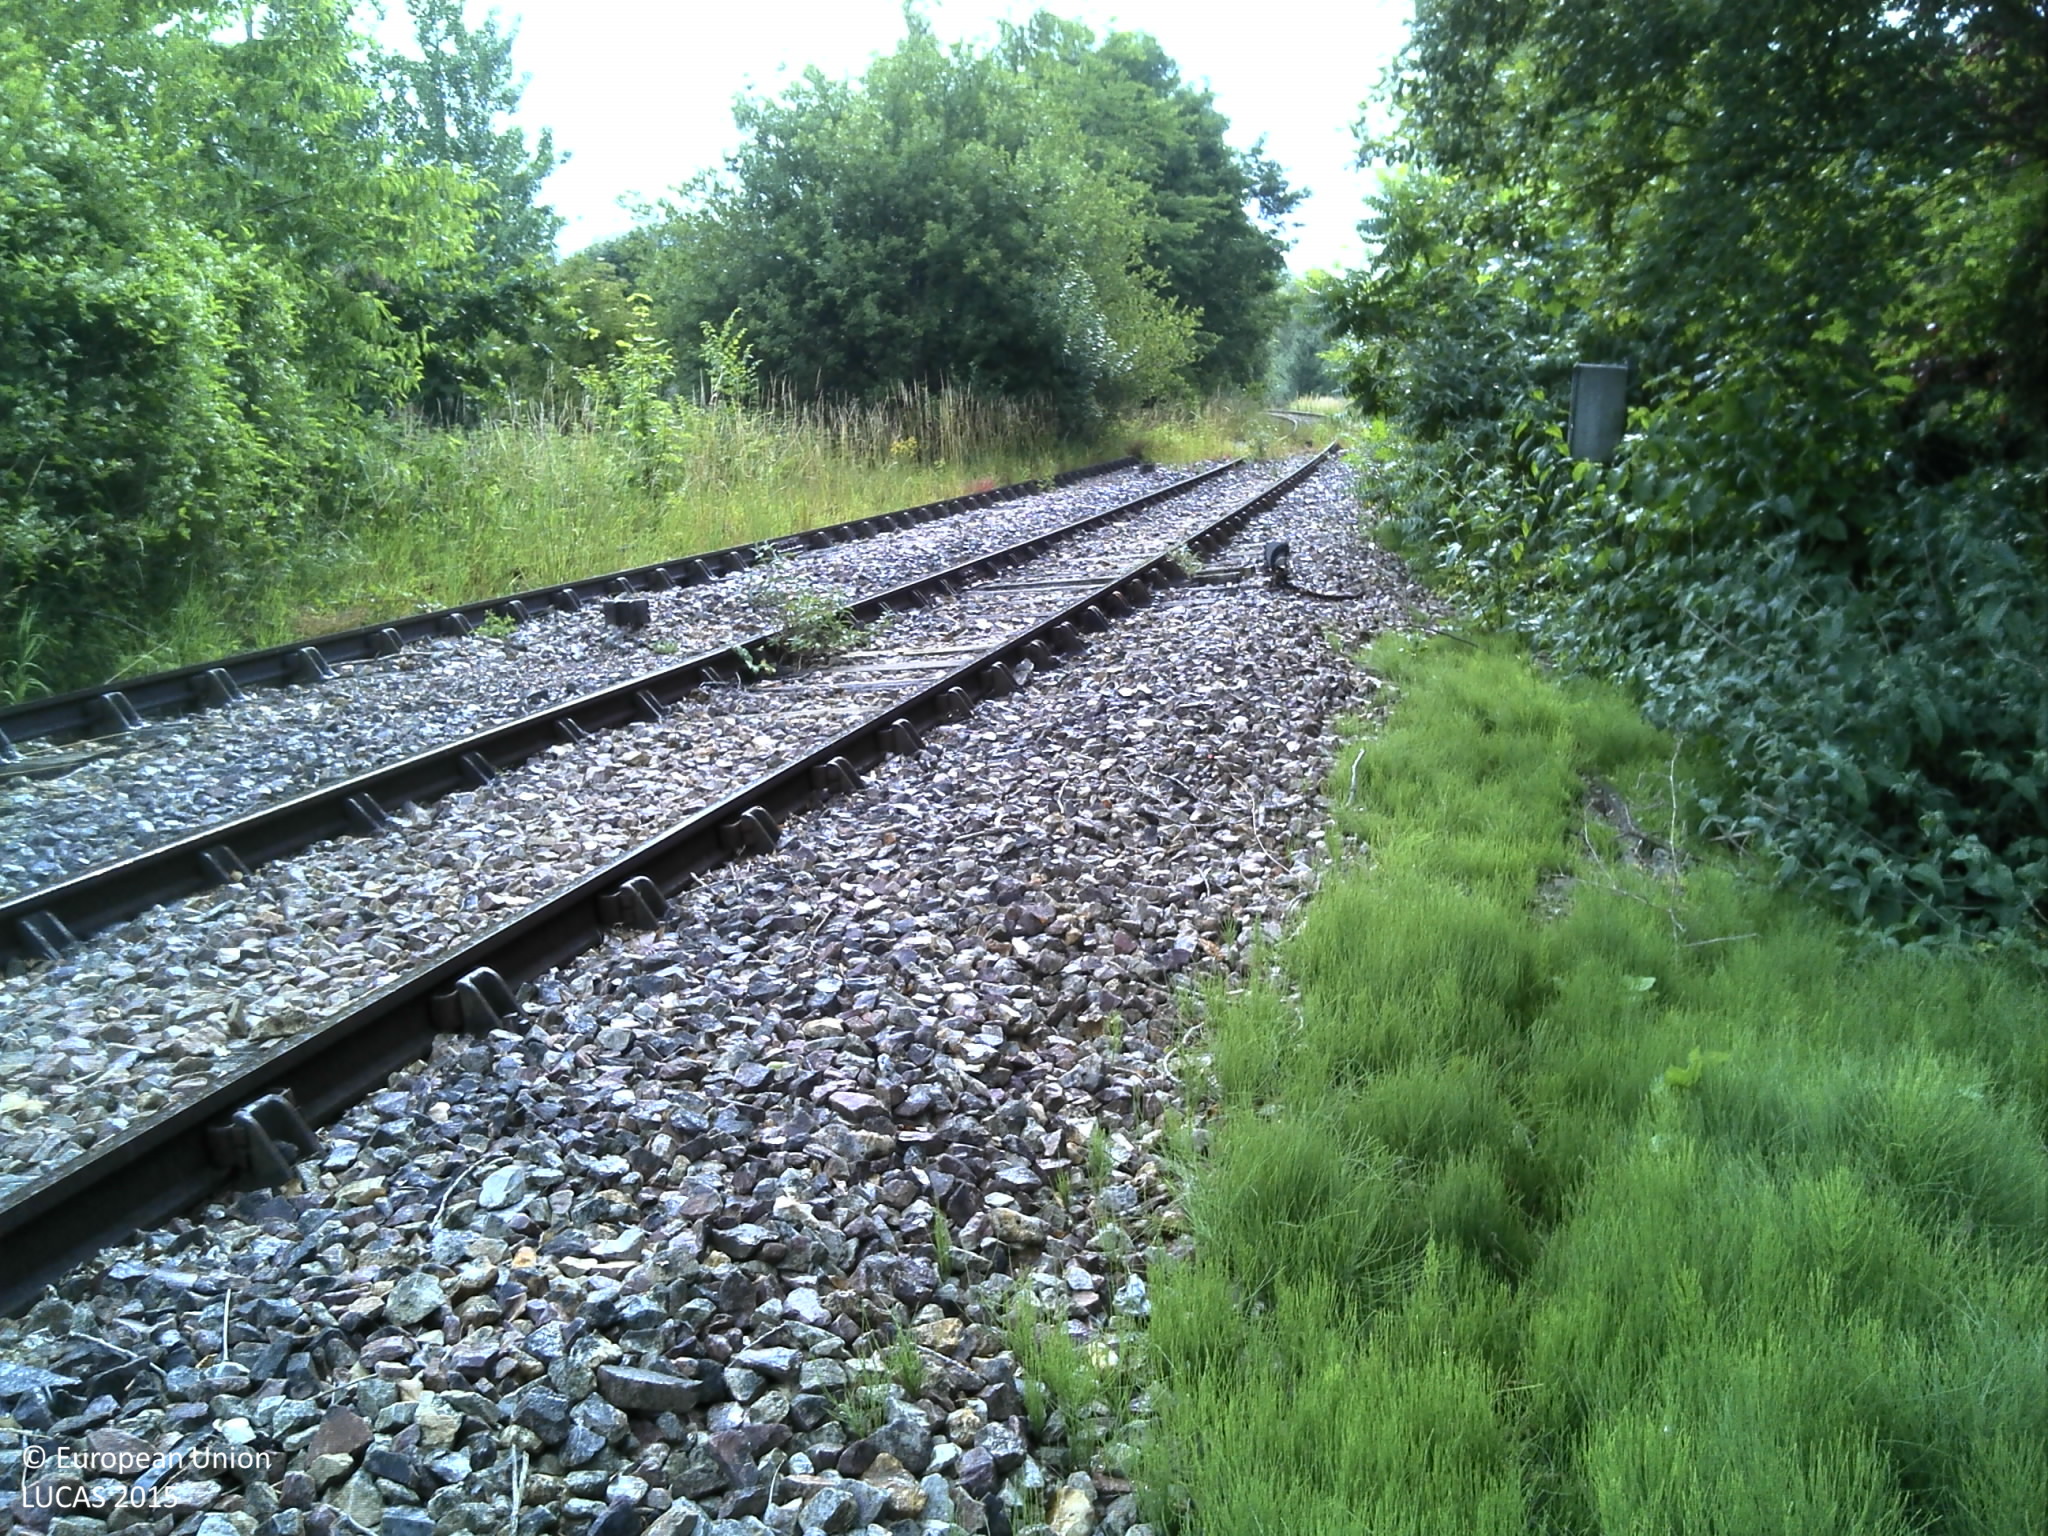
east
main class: Woodland
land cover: Broadleaved woodland
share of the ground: 50 - 75 %
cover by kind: broadleaved forest trees 100 %
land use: Semi-natural and natural areas not in use
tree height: < 5 m
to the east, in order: Broadleaved woodland; Railways; Inland fresh running water; Lines of trees; Fences; Grassland without tree/shrub cover
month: July
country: FR
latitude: 49.8751
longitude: 1.1424
